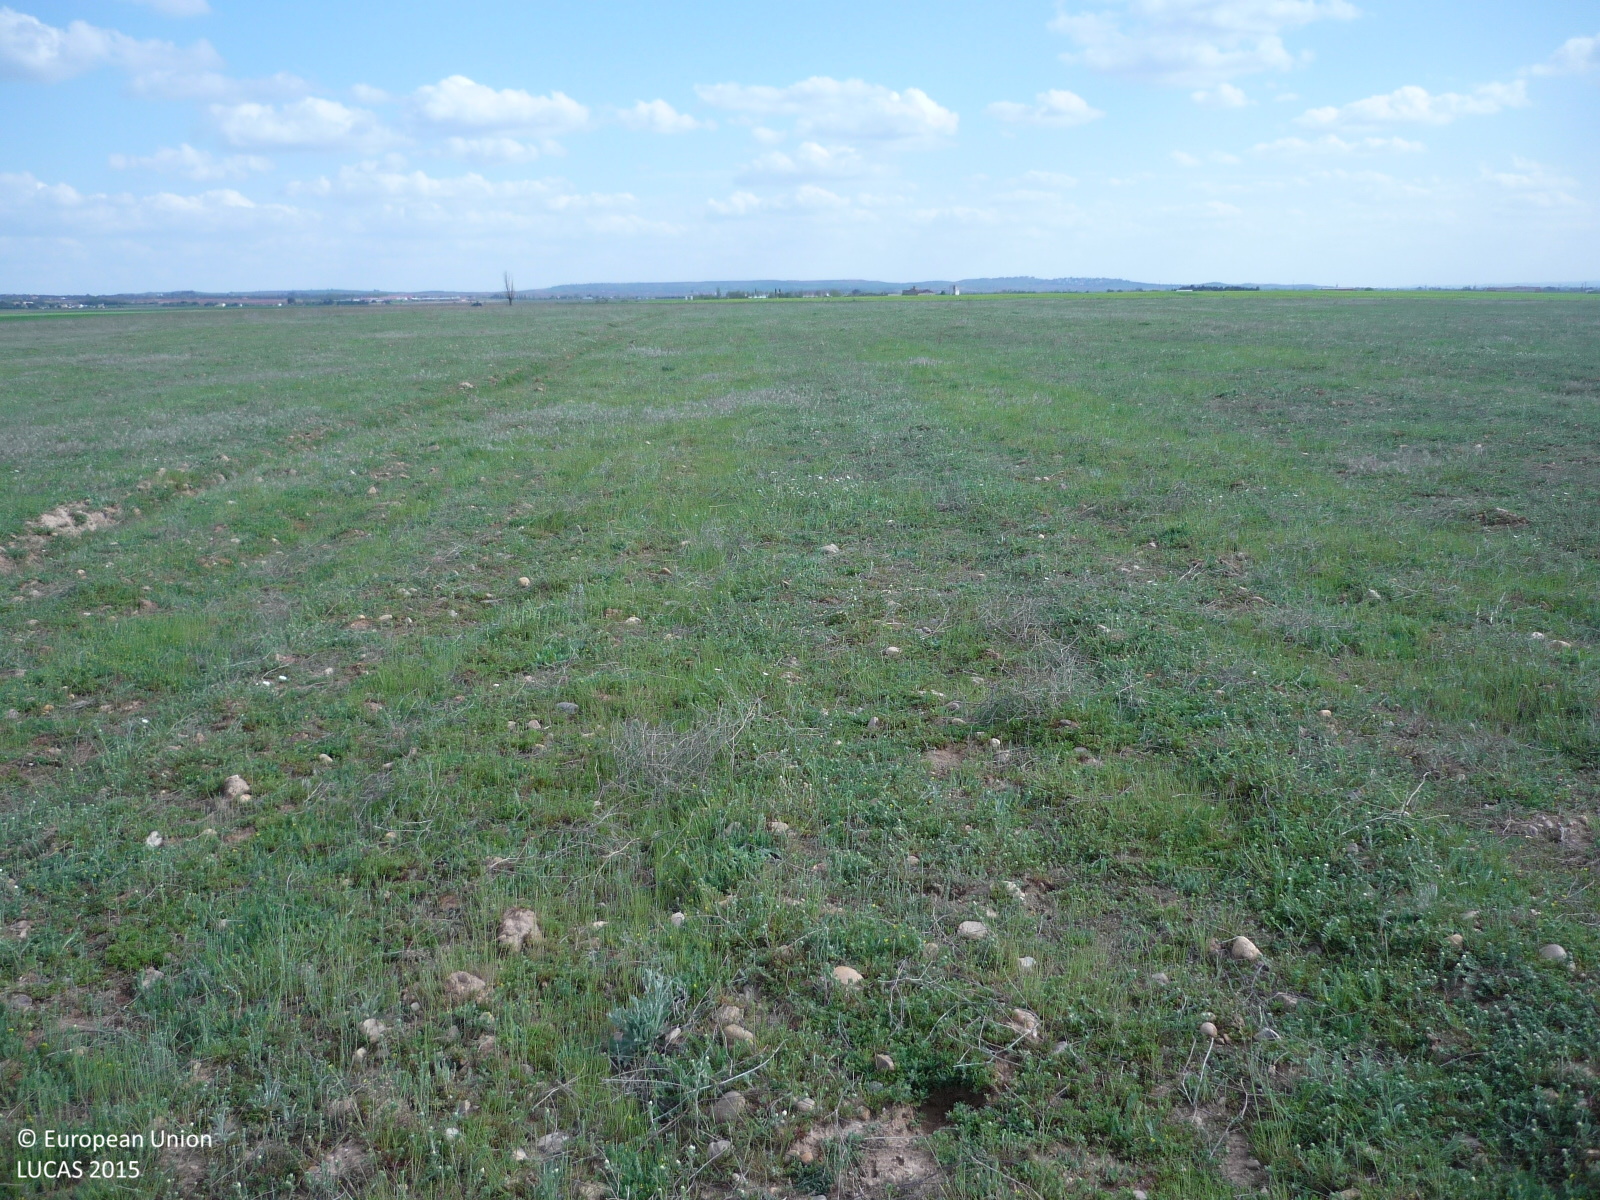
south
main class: Grassland
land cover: Spontaneously vegetated surfaces
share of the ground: > 75 %
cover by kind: herbaceous plants 95 %, consolidated bare surface 5 %
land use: Fallow land
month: April
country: ES
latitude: 40.7034
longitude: -3.4955
